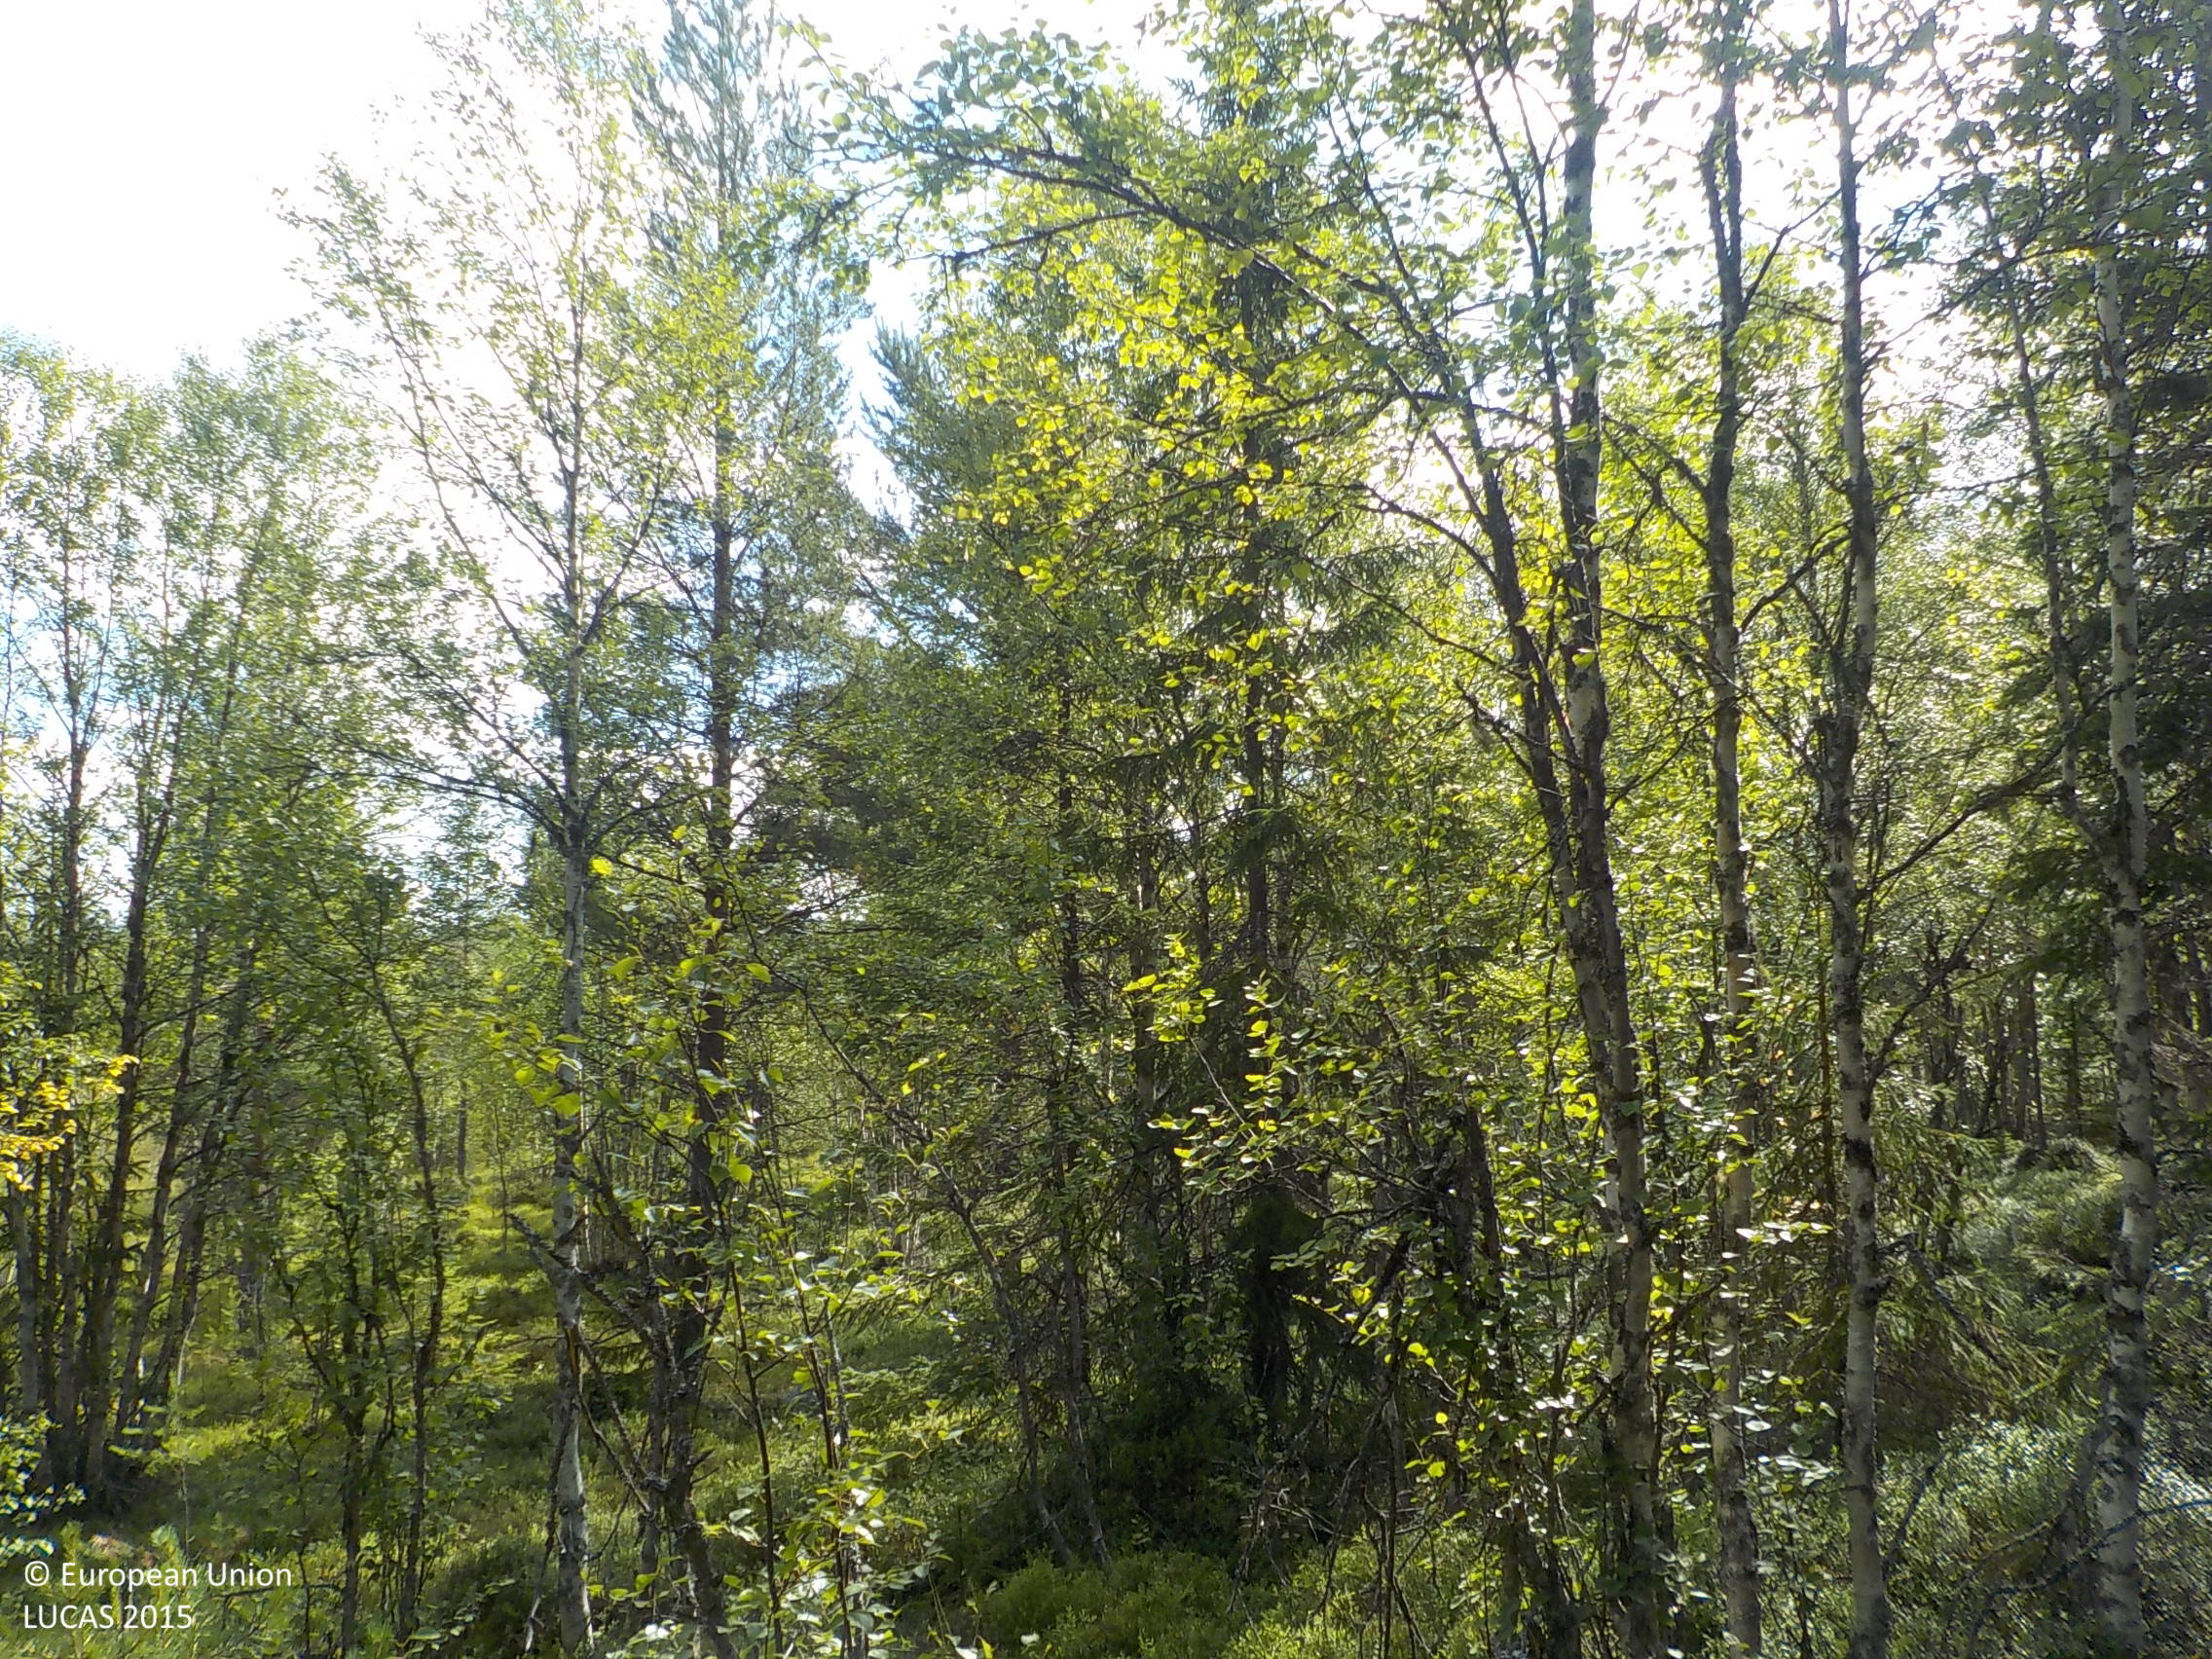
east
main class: Woodland
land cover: Pine dominated mixed woodland
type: boreal forest
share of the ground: > 75 %
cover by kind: coniferous forest trees 50 %, broadleaved forest trees 30 %, shrubs 20 %
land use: Forestry
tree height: > 5 m
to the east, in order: Pine dominated mixed woodland; Pine dominated coniferous woodland; Peatbogs
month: August
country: SE
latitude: 64.0680
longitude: 17.6562
